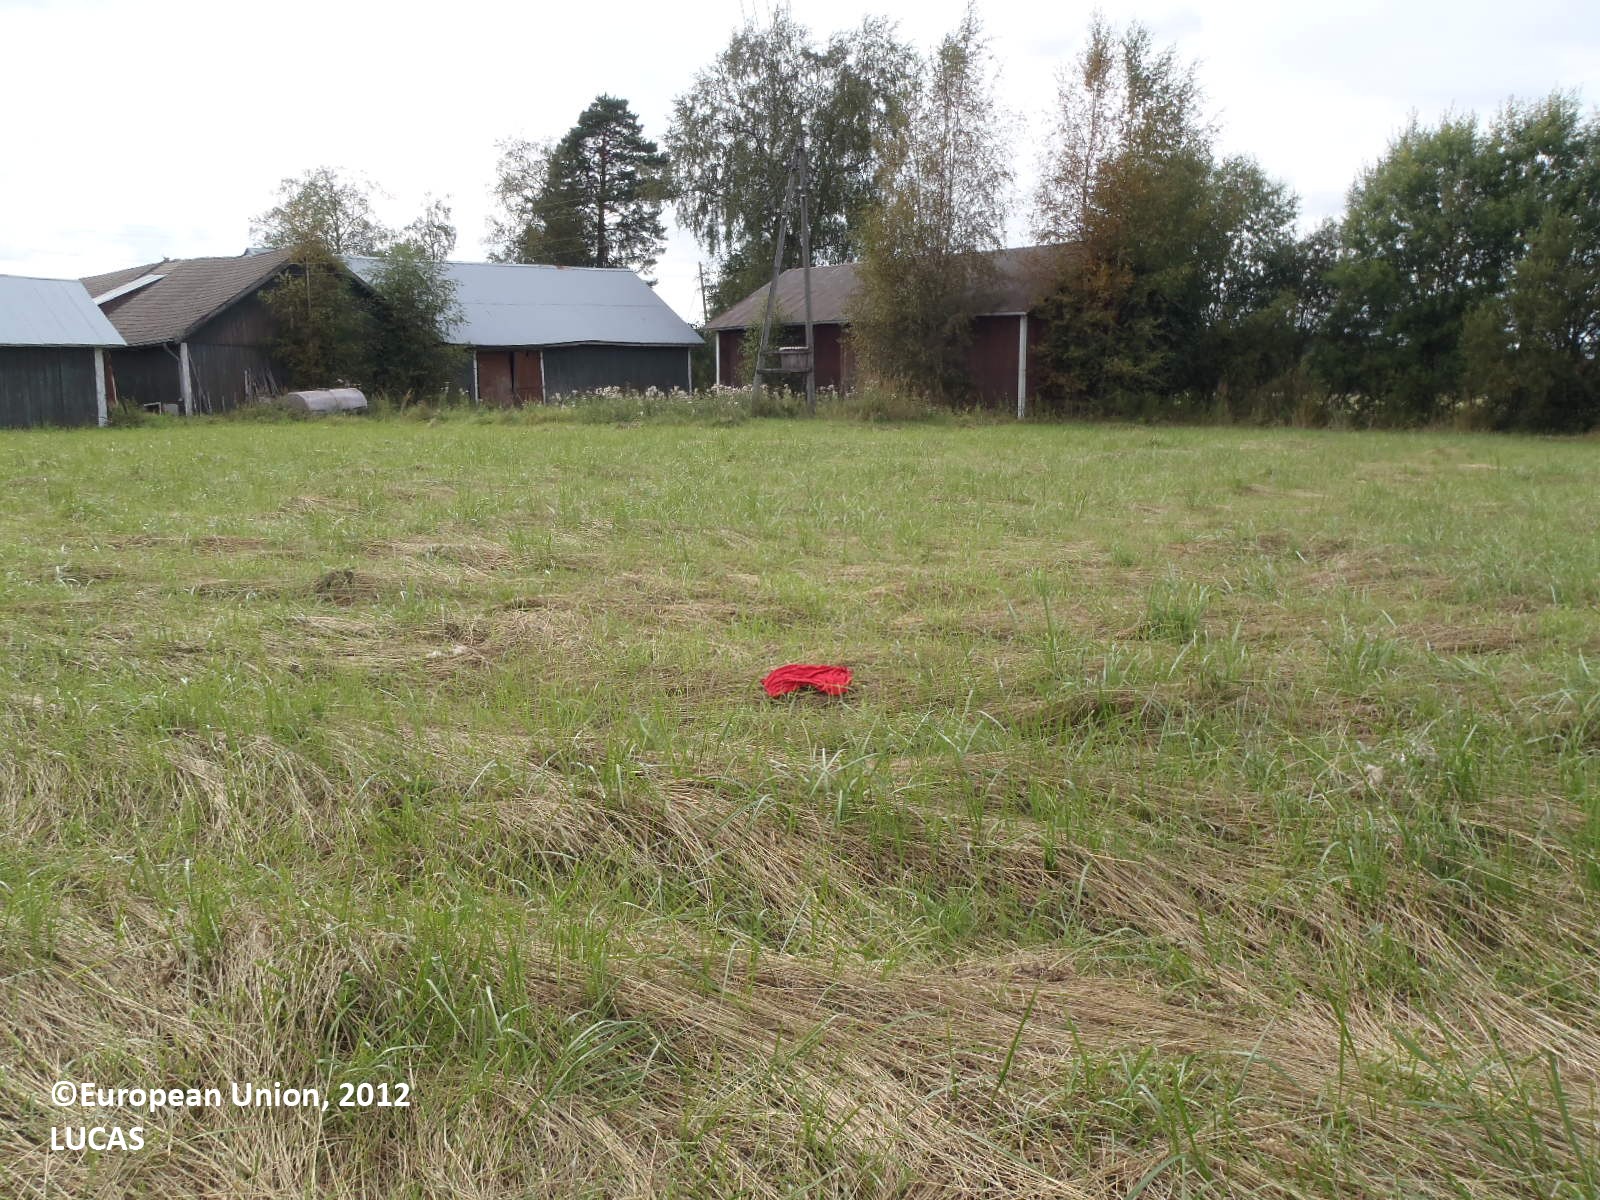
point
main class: Cropland
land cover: Temporary grasslands
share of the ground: > 75 %
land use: Agriculture (excluding fallow land and kitchen gardens)
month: August
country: FI
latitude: 60.6491
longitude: 22.4505
